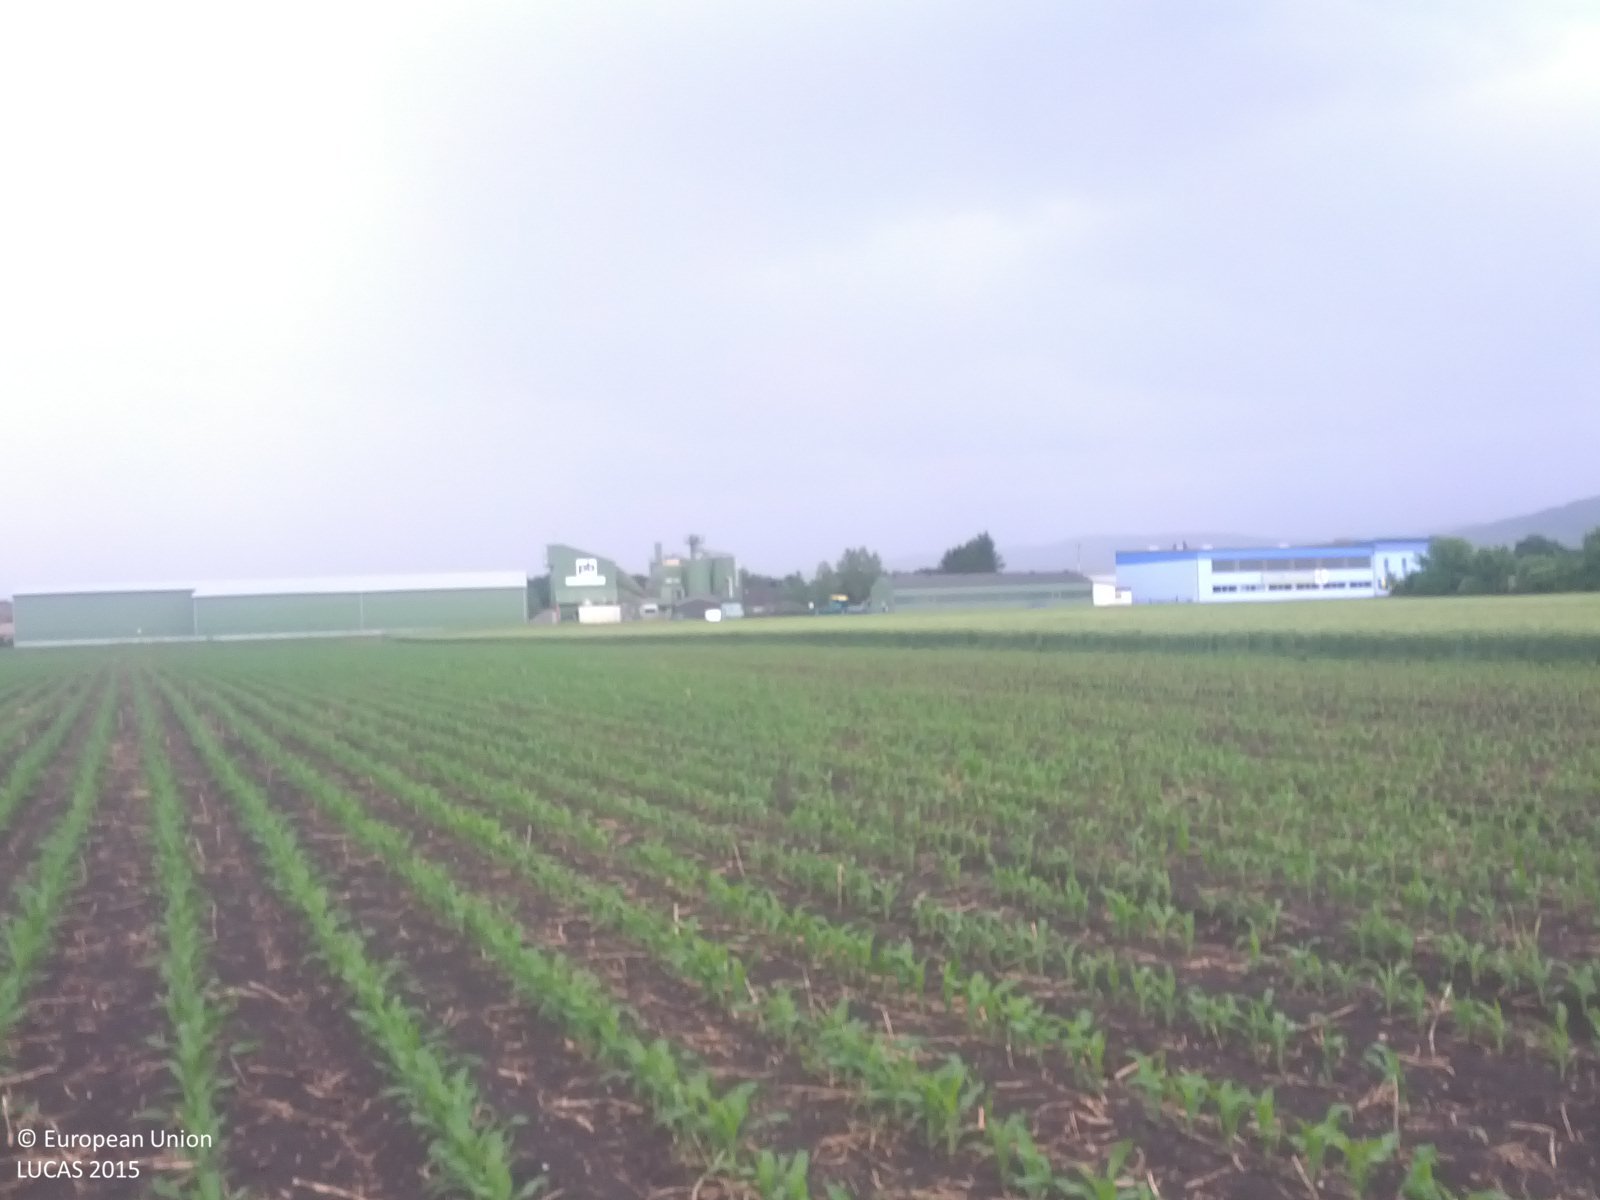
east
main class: Cropland
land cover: Maize
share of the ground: 10 - 25 %
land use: Agriculture (excluding fallow land and kitchen gardens)
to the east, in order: Maize; Barley; Grass margins; Artificial constructions in urban areas
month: May
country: AT
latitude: 48.3066
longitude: 16.1119
